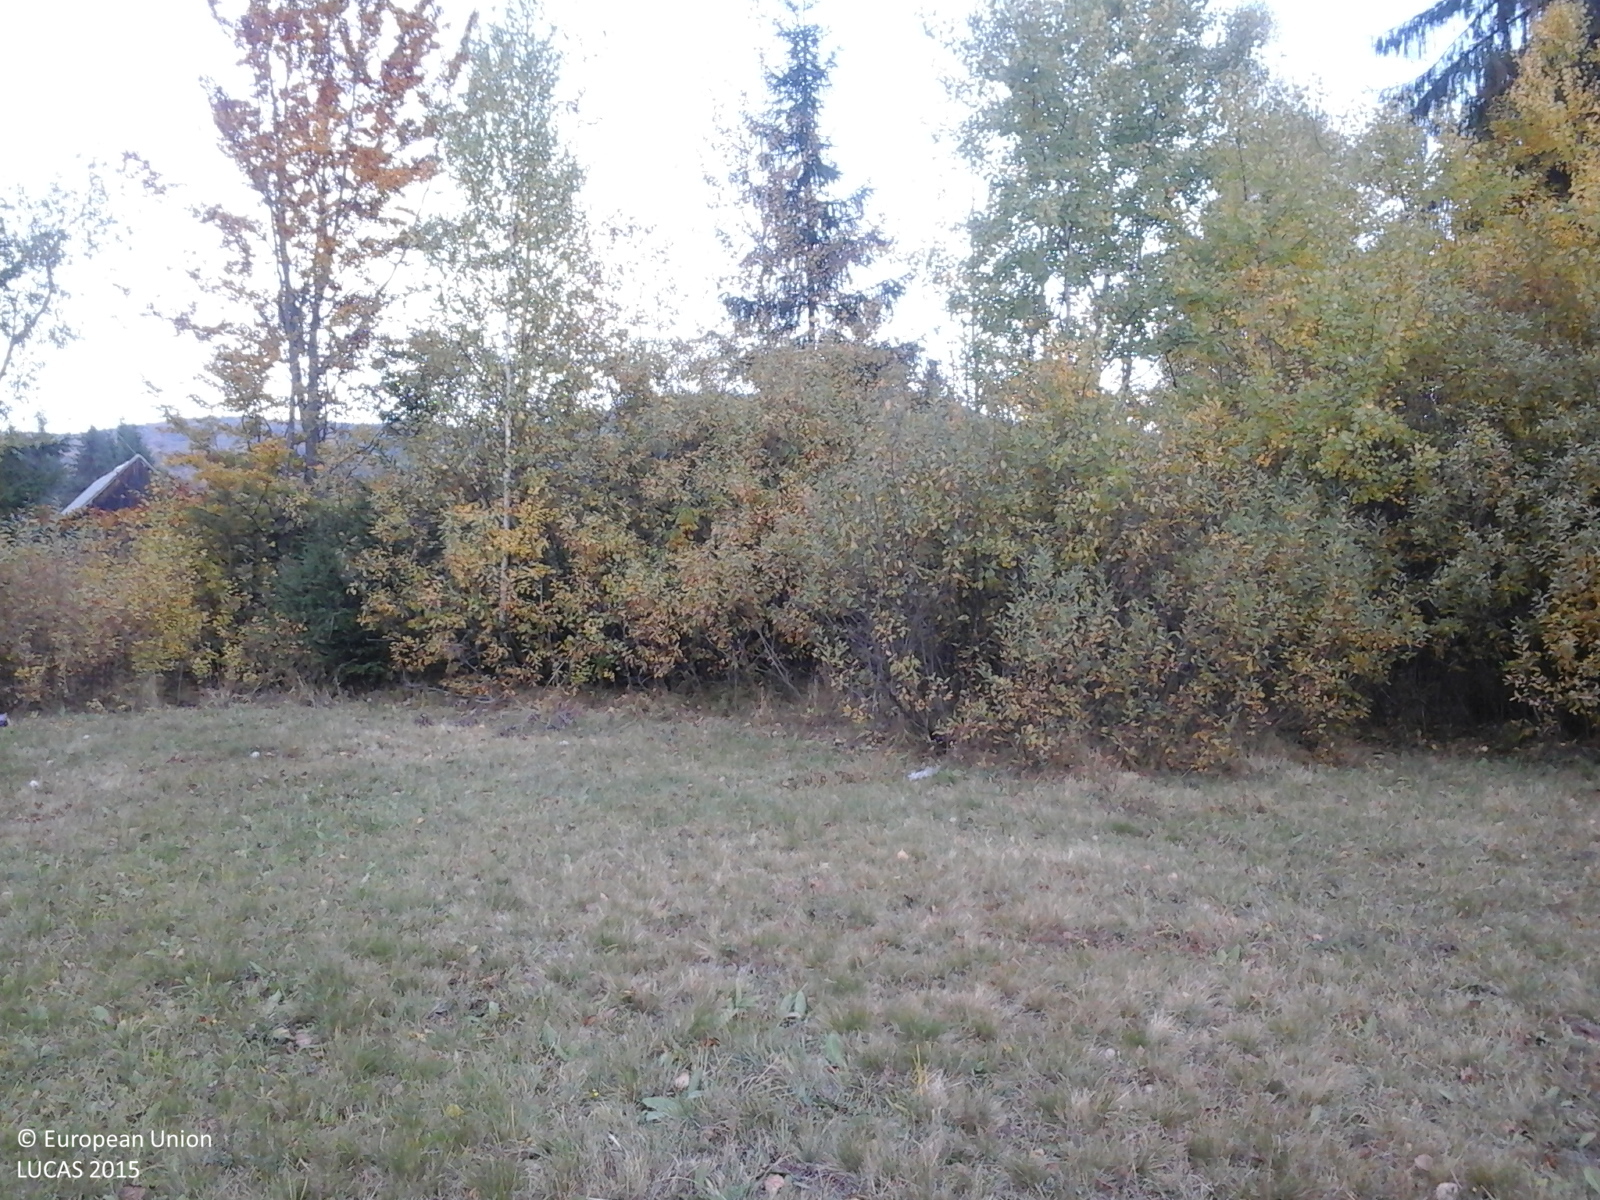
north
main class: Grassland
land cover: Grassland without tree/shrub cover
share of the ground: > 75 %
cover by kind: herbaceous plants 100 %
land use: Agriculture (excluding fallow land and kitchen gardens)
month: October
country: RO
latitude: 46.5488
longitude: 25.5120
